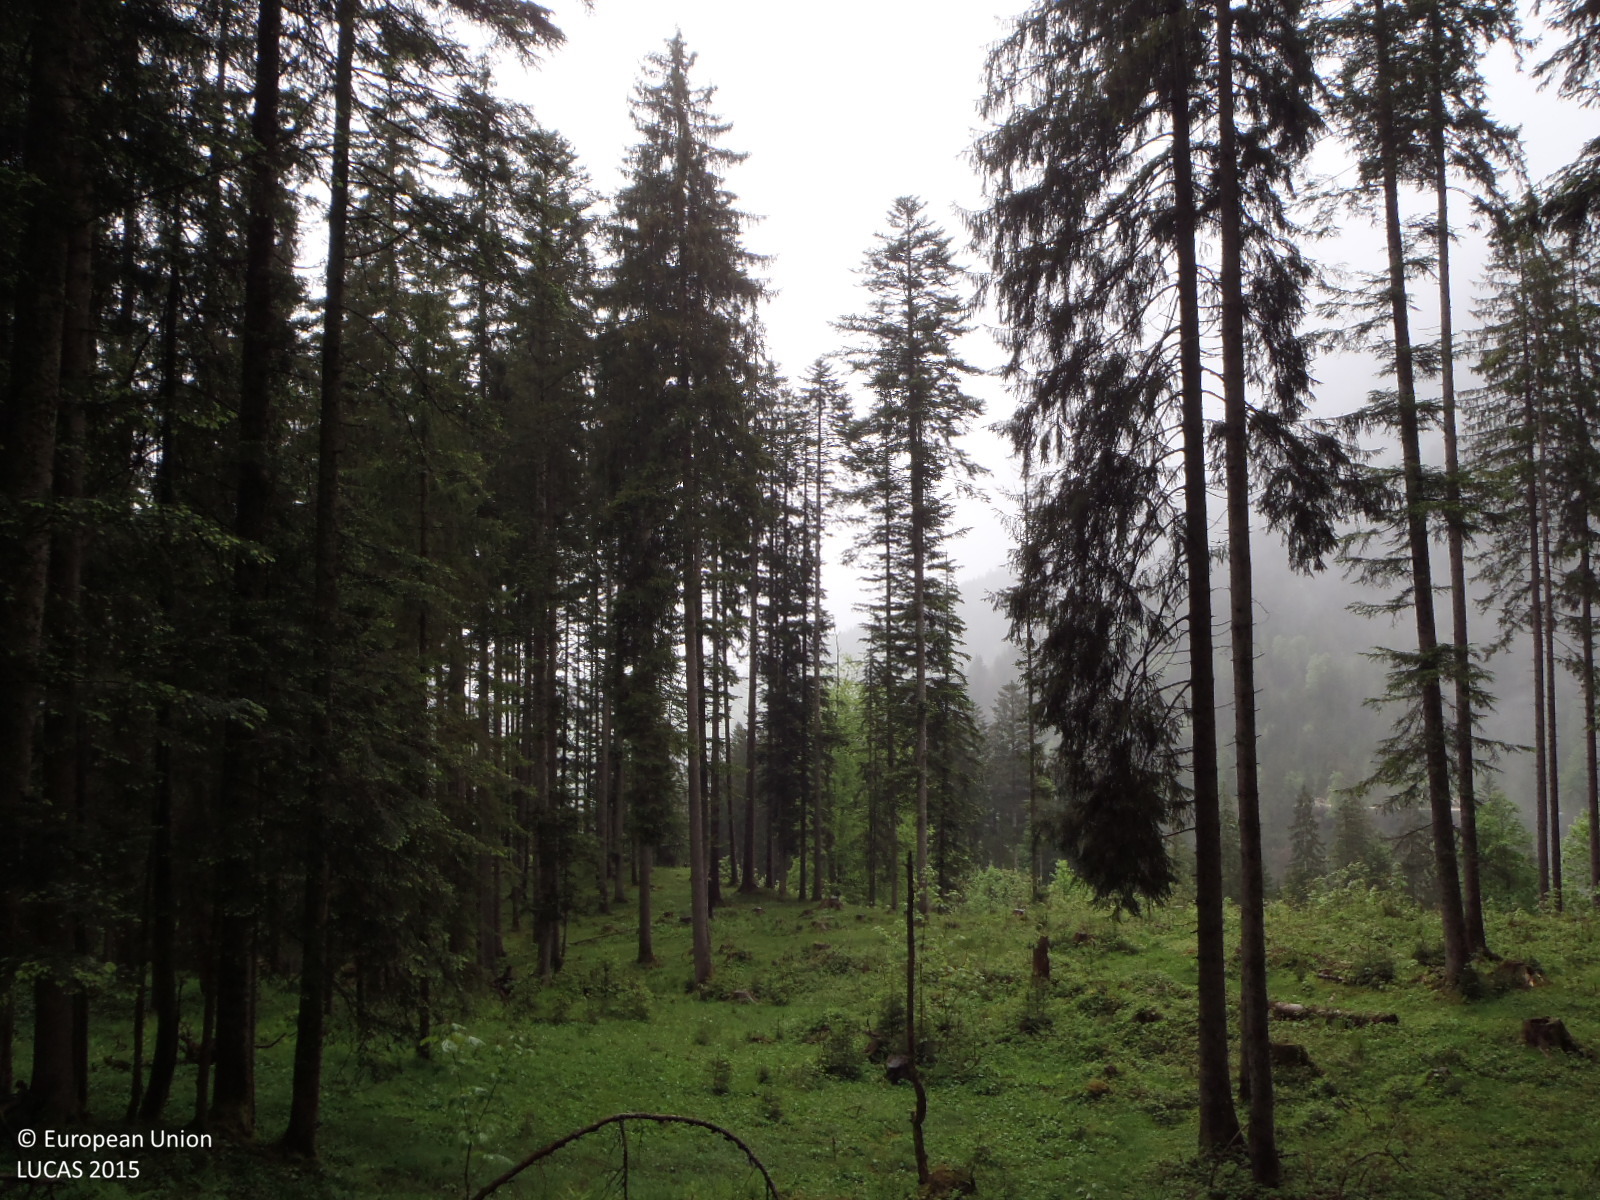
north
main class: Woodland
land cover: Other coniferous woodland
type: alpine coniferous forest
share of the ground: 50 - 75 %
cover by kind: coniferous forest trees 60 %, herbaceous plants 20 %, shrubs 10 %, lichens and mosses 10 %
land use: Forestry
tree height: > 5 m
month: May
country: AT
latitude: 47.5950
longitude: 12.7513
